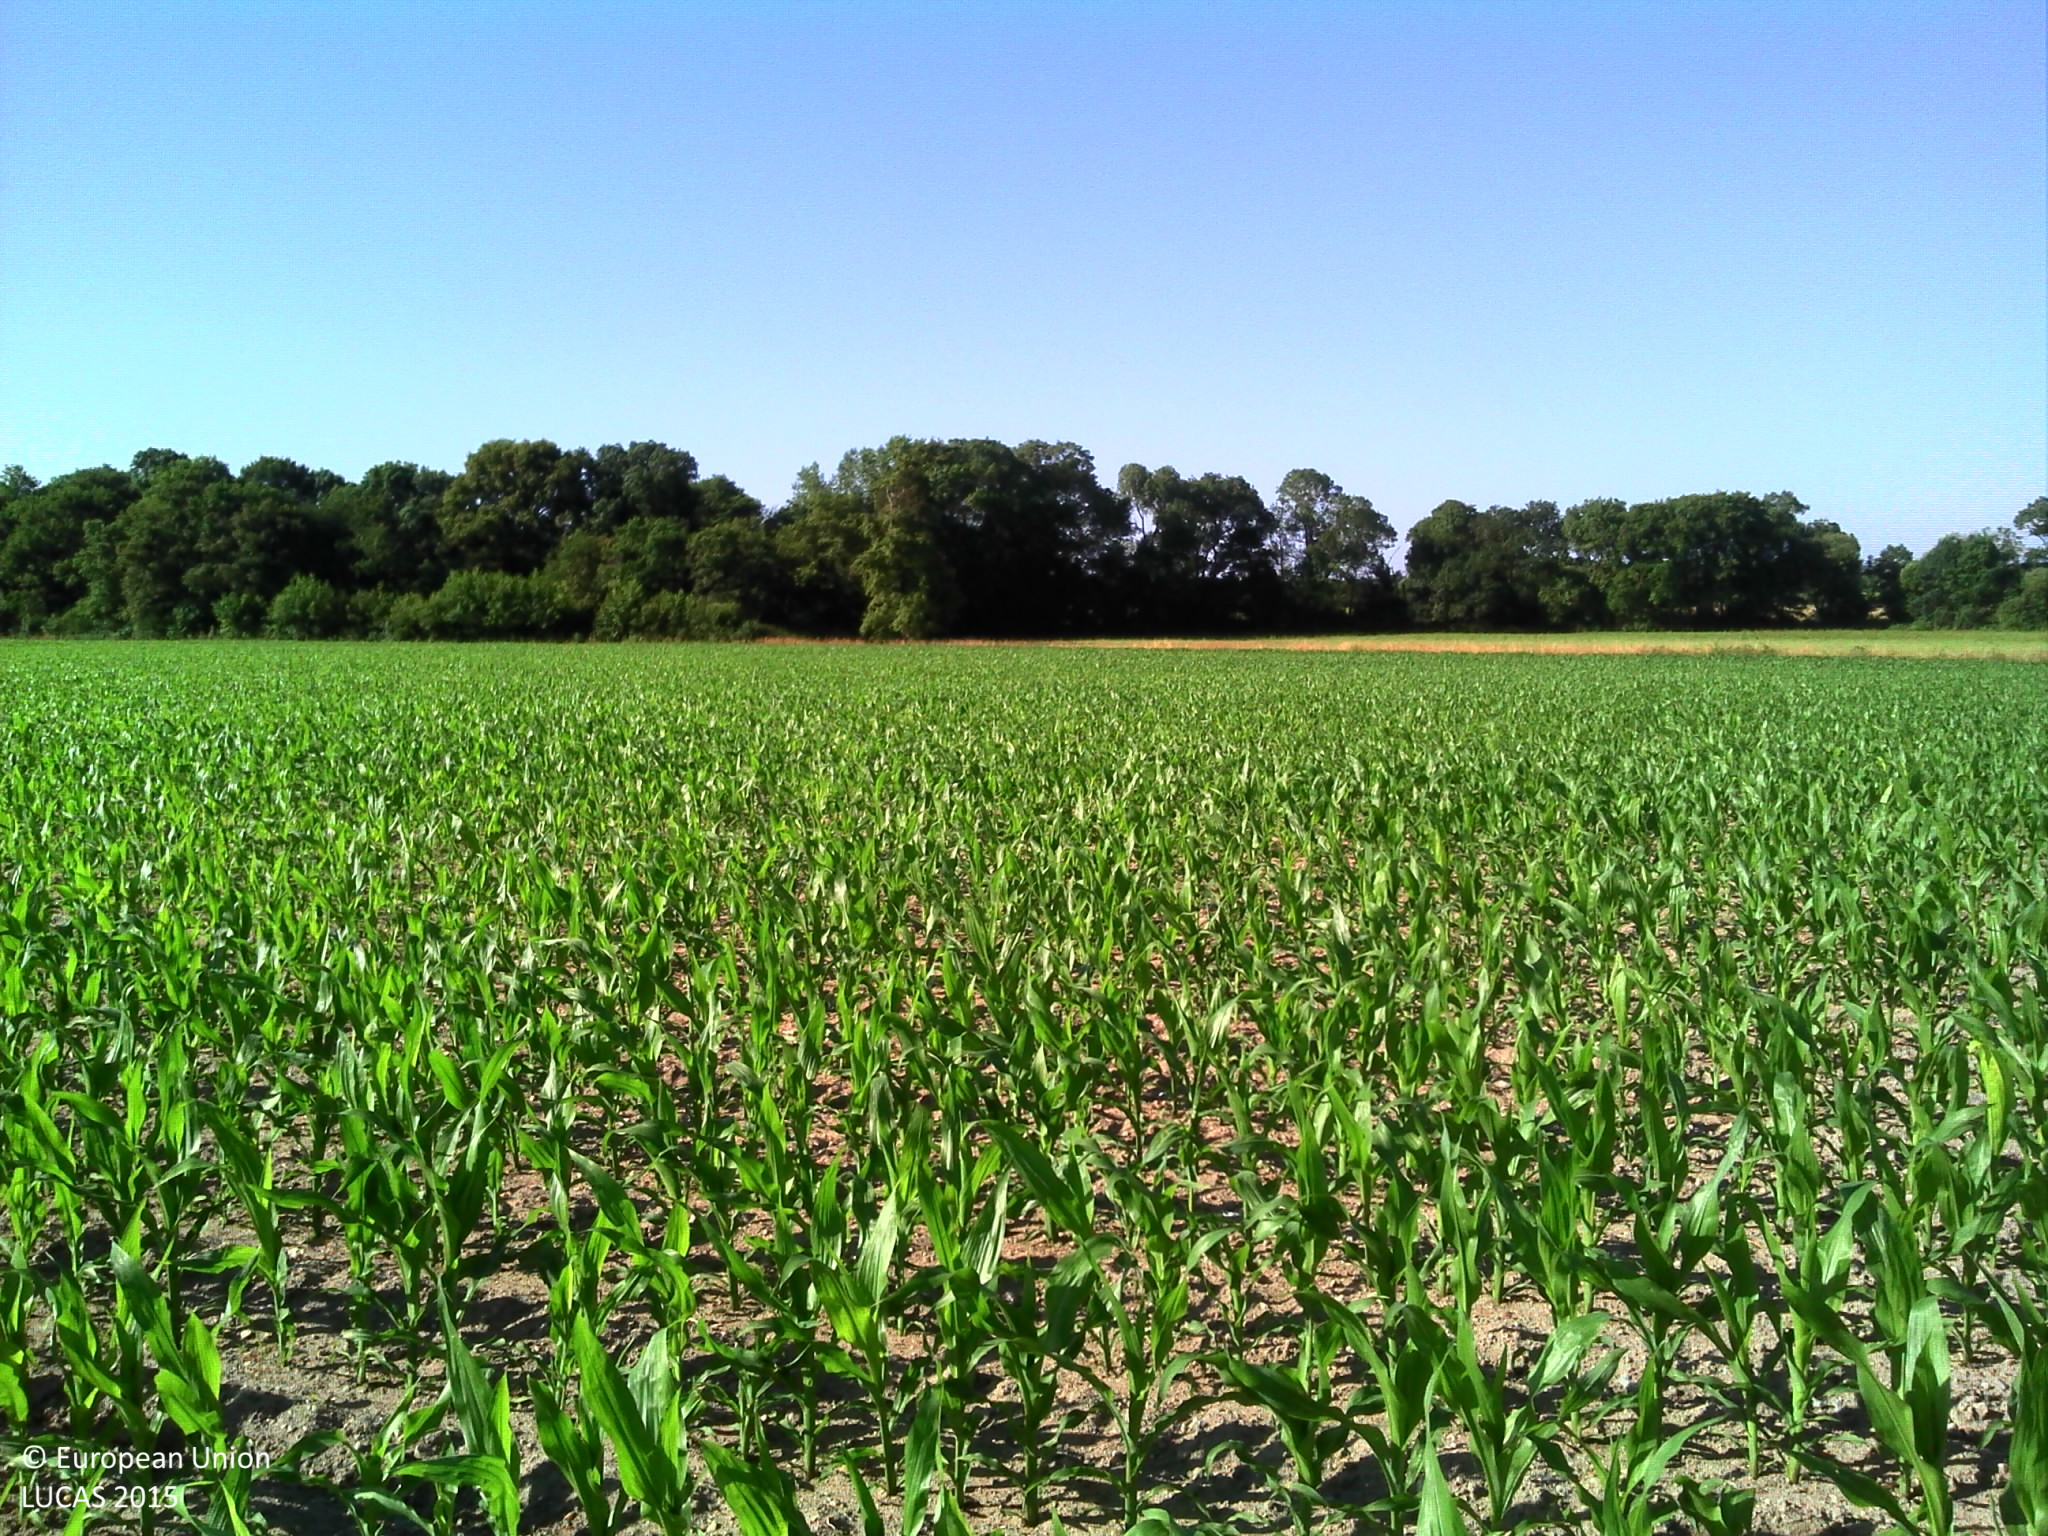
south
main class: Cropland
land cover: Maize
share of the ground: 25 - 50 %
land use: Agriculture (excluding fallow land and kitchen gardens)
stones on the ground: 10 - 25 %
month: June
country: FR
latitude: 46.9767
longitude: -1.7295
